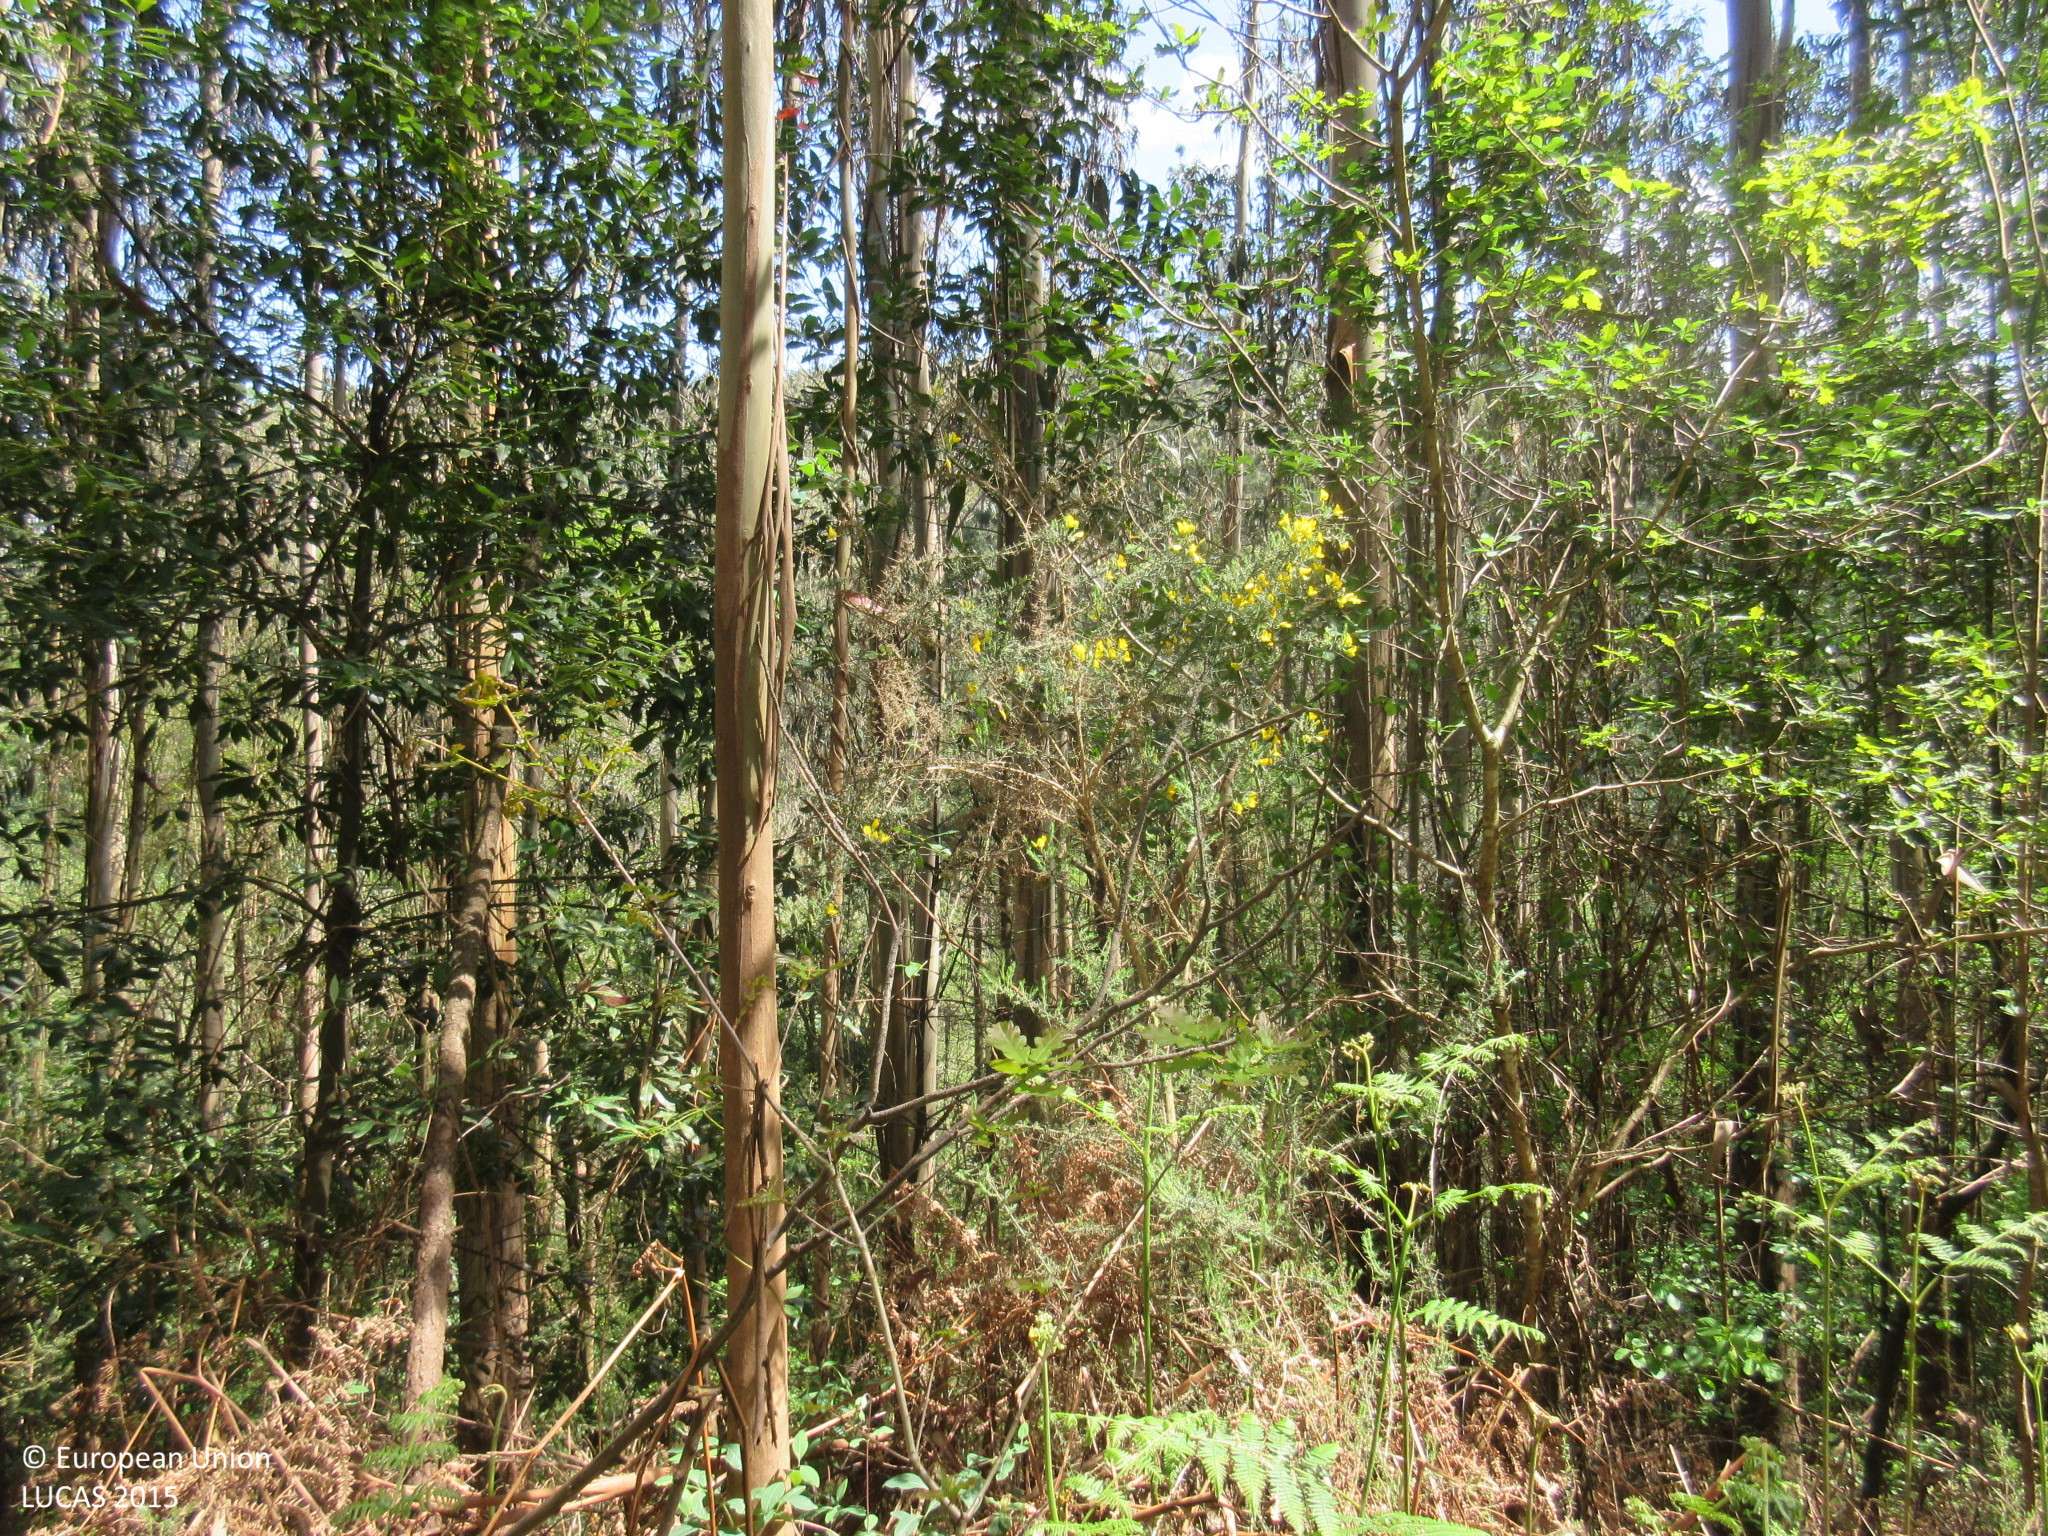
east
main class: Woodland
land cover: Broadleaved woodland
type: exotic forest
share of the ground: > 75 %
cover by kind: broadleaved forest trees 95 %, shrubs 5 %
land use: Forestry
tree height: > 5 m
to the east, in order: Broadleaved woodland; Tracks; Broadleaved woodland; Rivers and streams; Broadleaved woodland
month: April
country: ES
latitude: 43.5109
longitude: -7.0785
